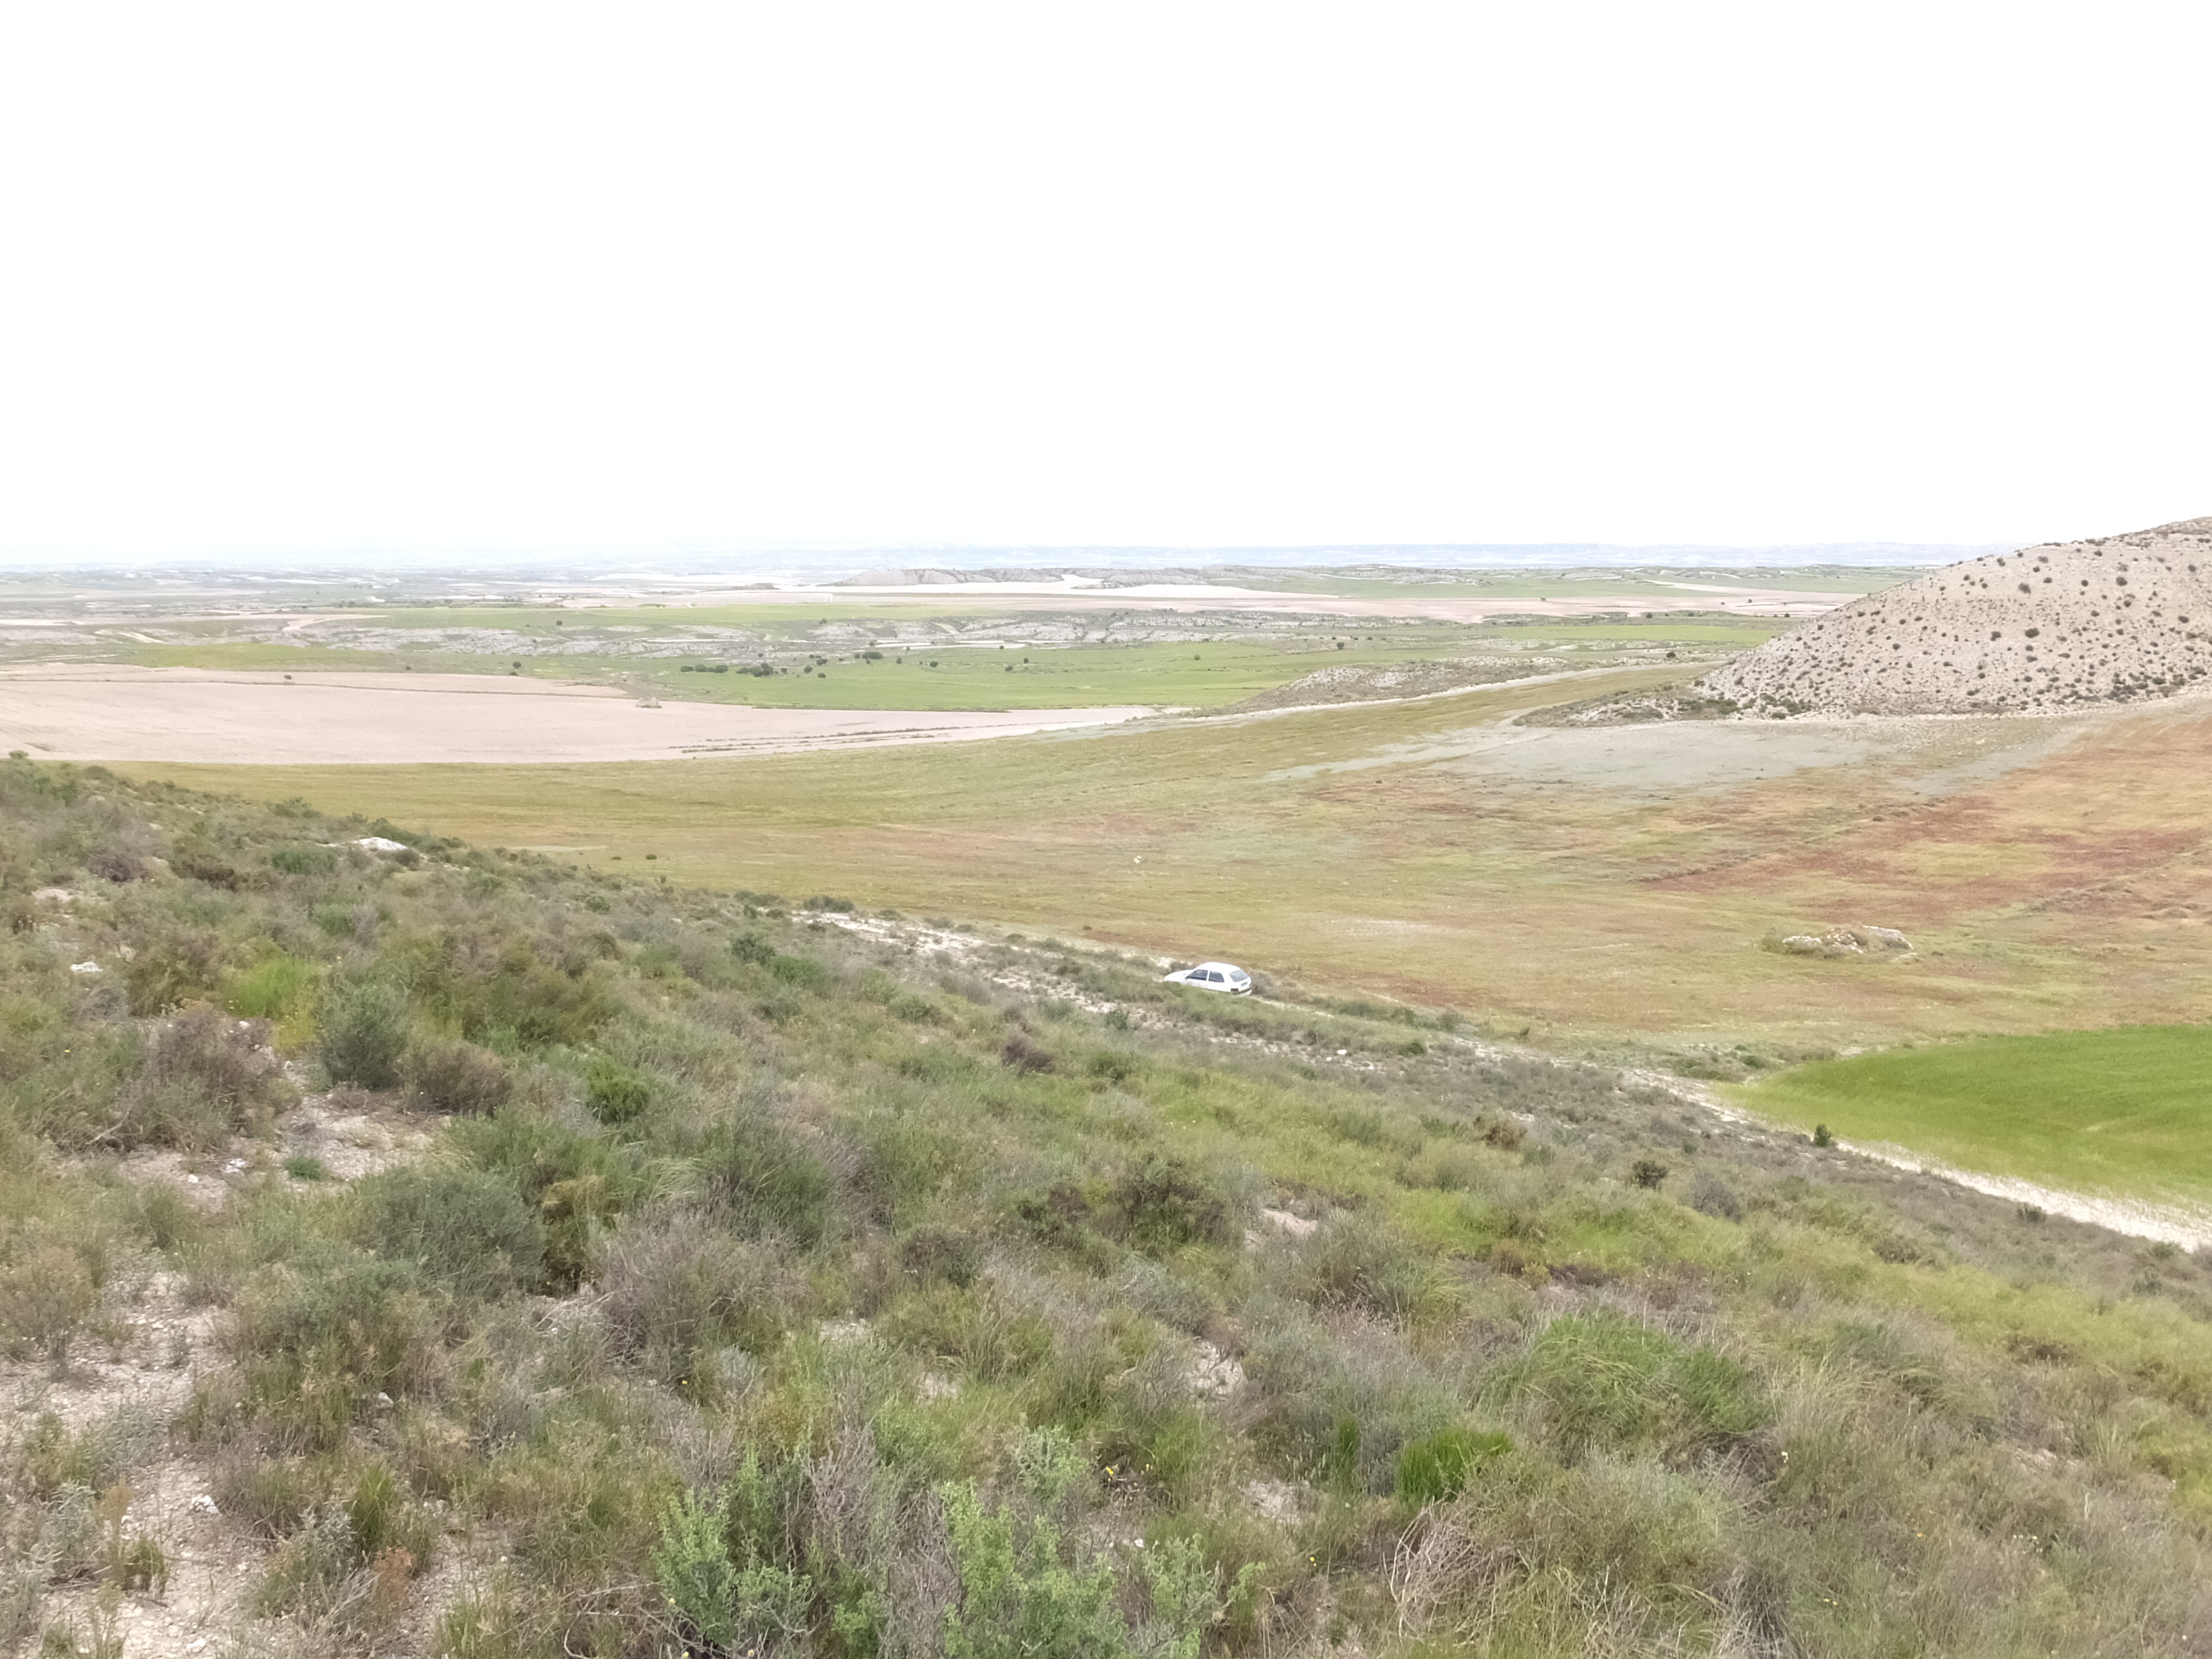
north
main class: Shrubland
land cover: Shrubland with sparse tree cover
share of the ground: > 75 %
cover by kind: shrubs 85 %, herbaceous plants 10 %, coniferous forest trees 5 %
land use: Semi-natural and natural areas not in use
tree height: < 5 m
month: May
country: ES
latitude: 41.4494
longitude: -0.3465
